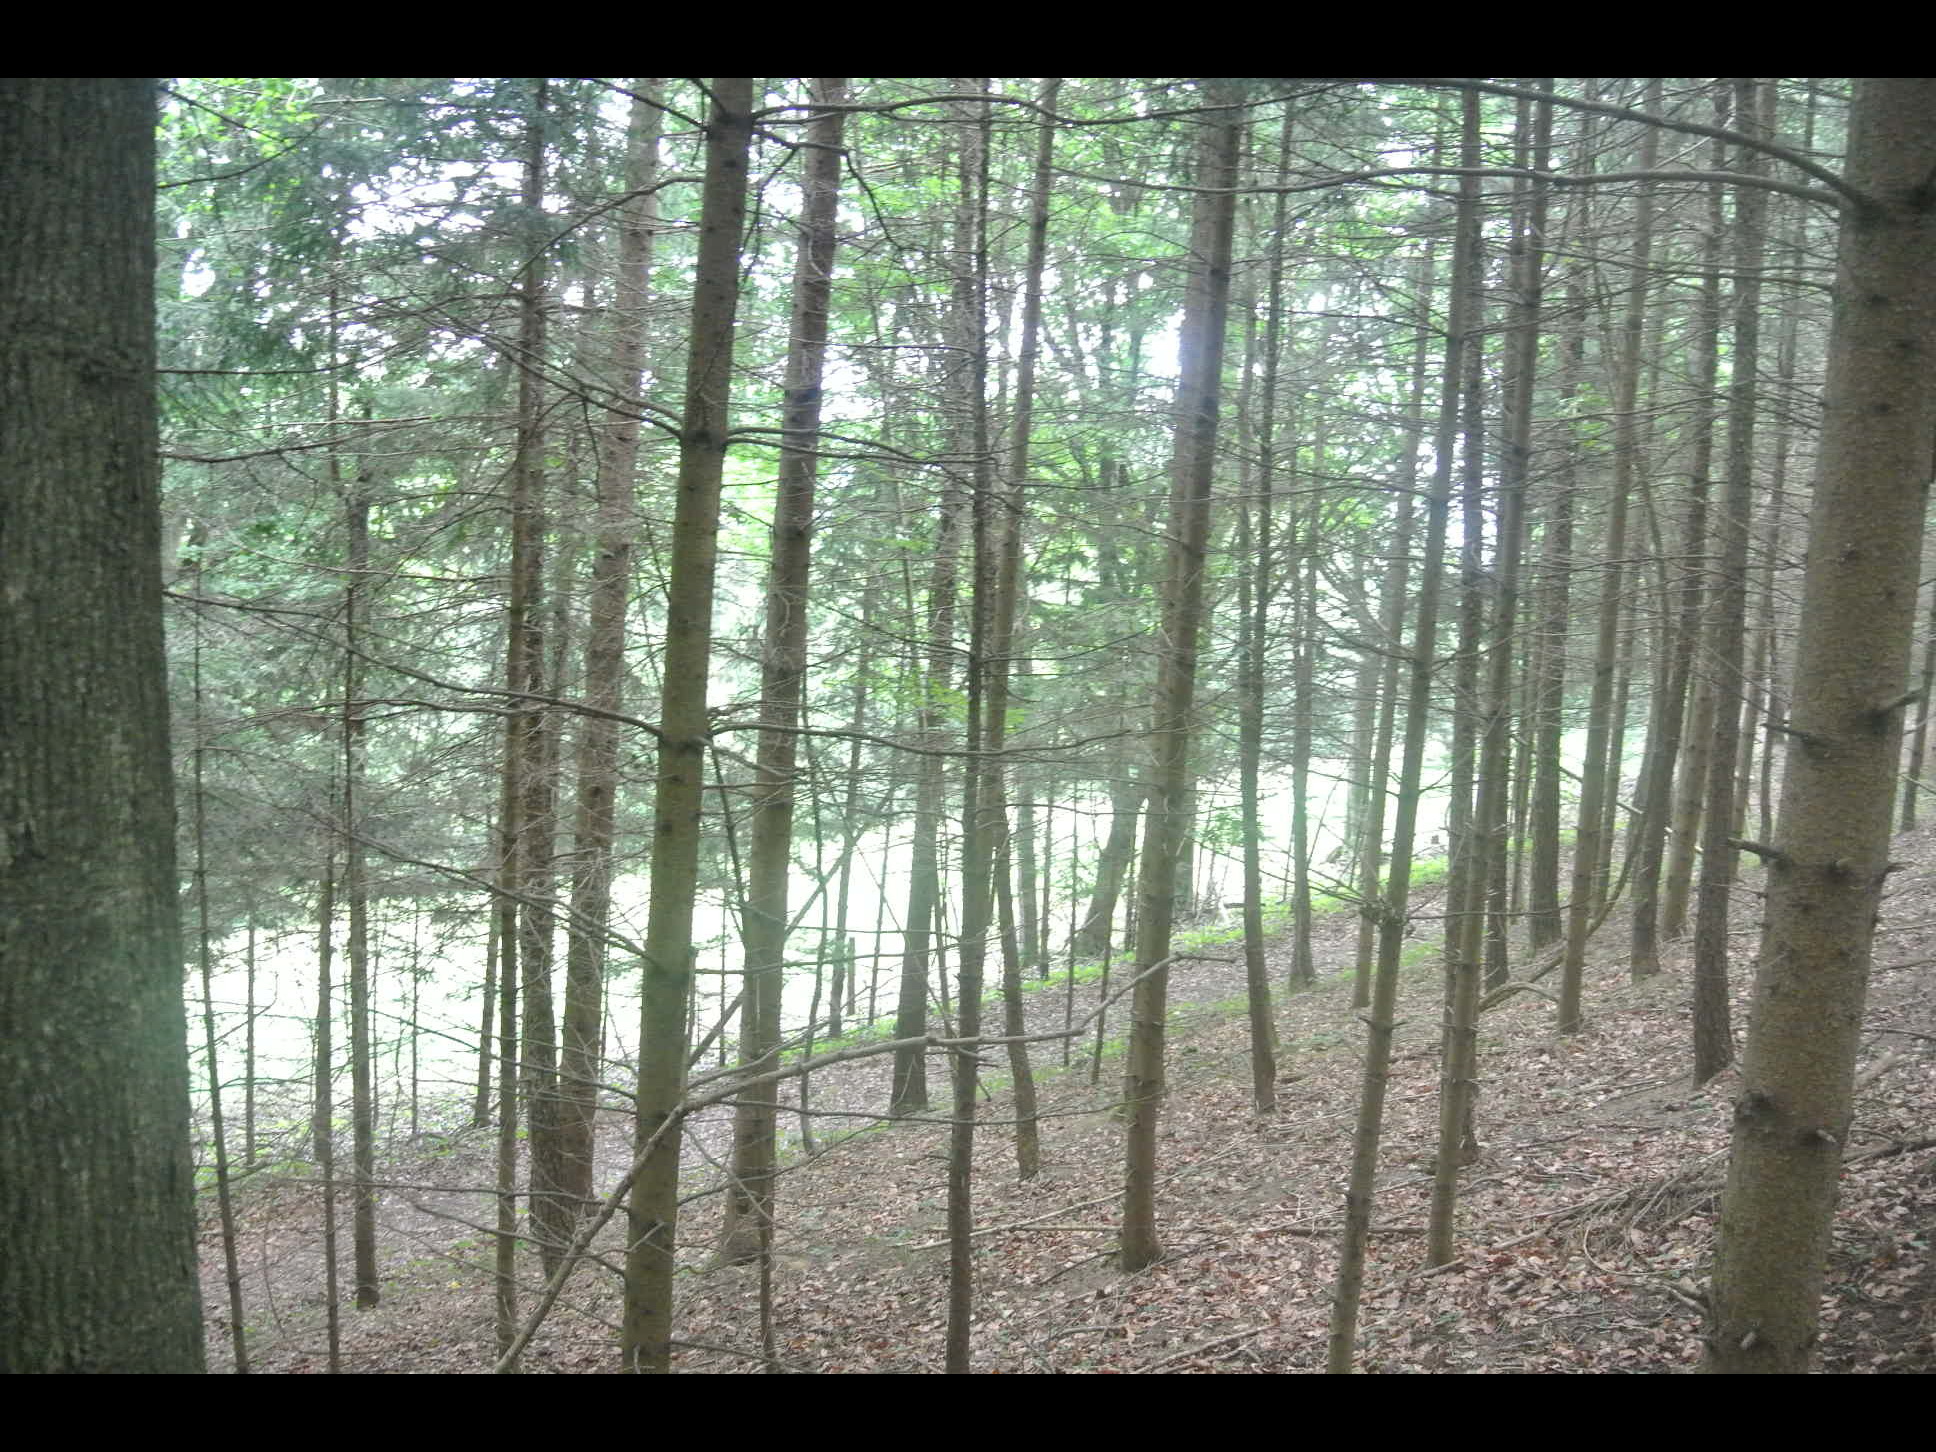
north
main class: Woodland
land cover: Spruce dominated mixed woodland
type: alpine coniferous forest
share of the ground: > 75 %
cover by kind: coniferous forest trees 70 %, broadleaved forest trees 30 %
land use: Forestry
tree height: > 5 m
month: July
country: AT
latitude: 48.0189
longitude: 15.4049
